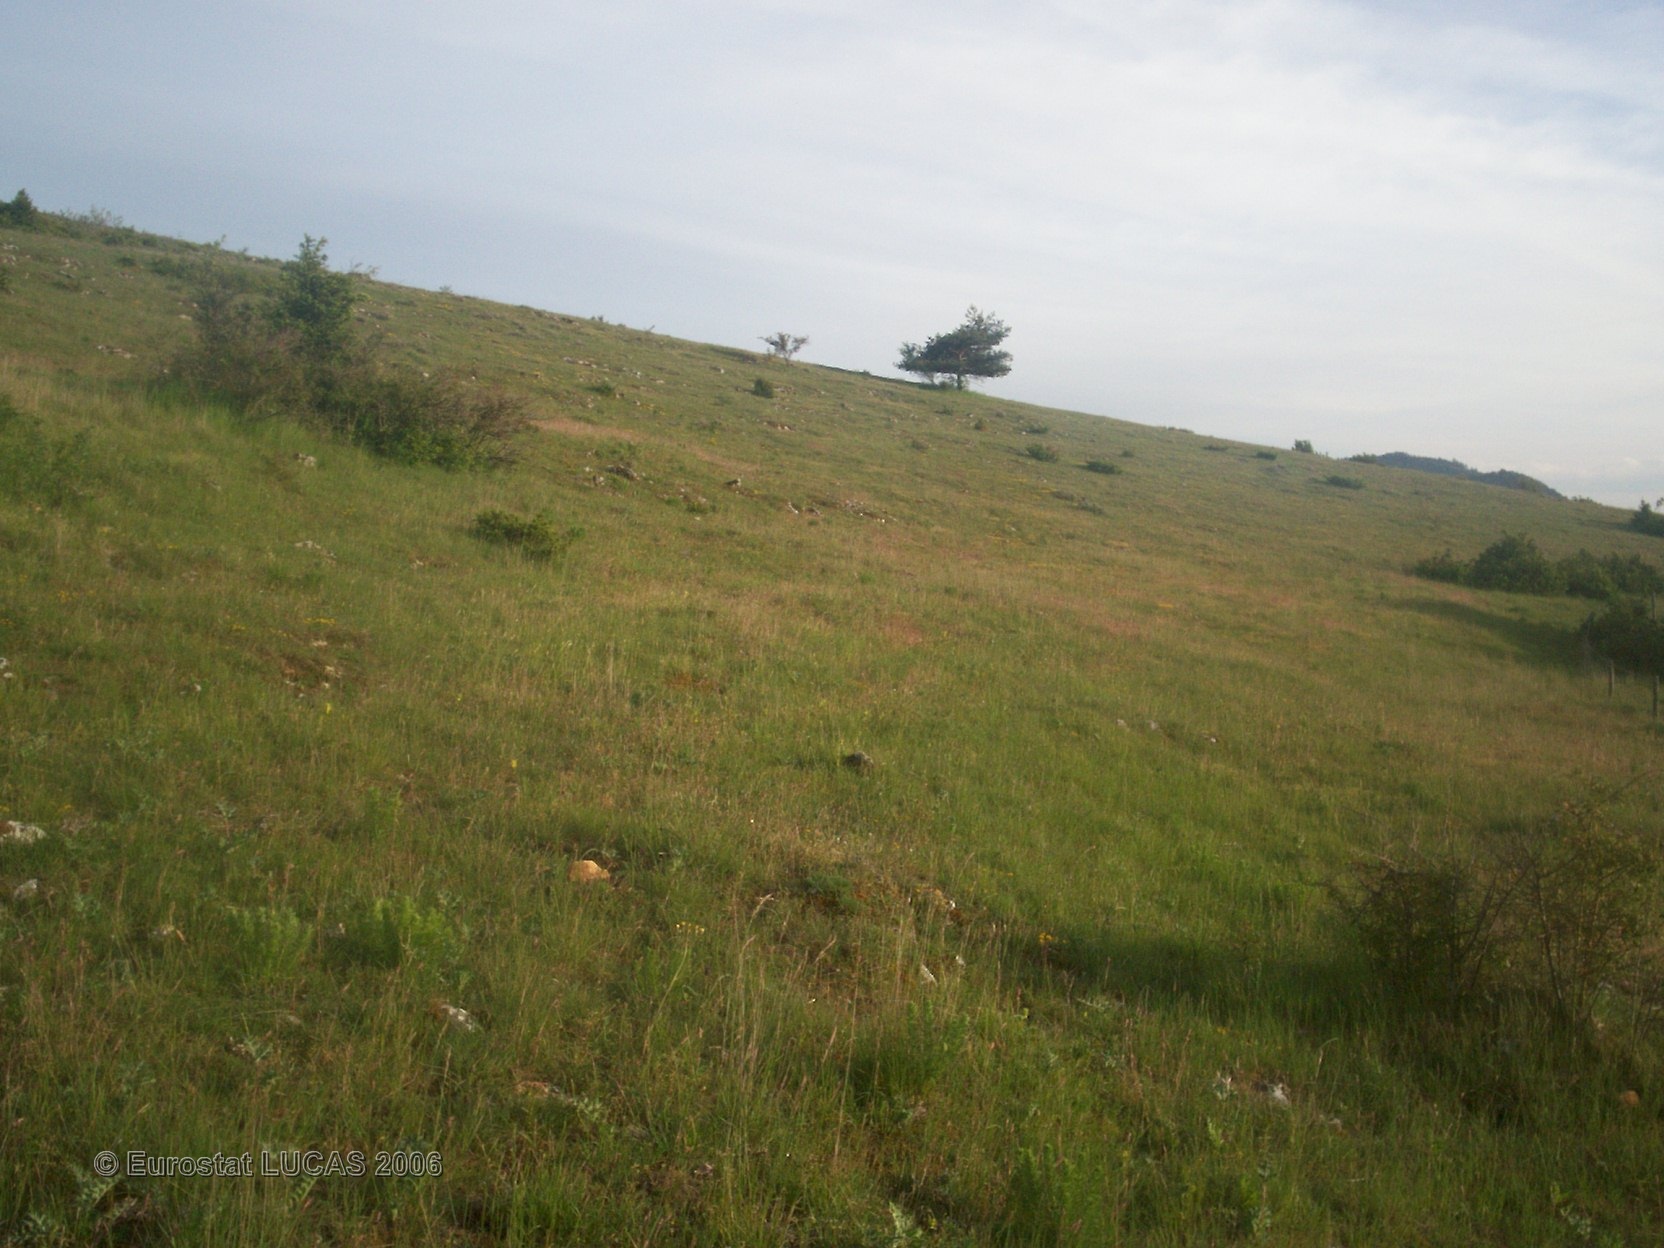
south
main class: Grassland
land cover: Grassland with sparse tree/shrub cover
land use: Agriculture (excluding fallow land and kitchen gardens)
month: June
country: FR
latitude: 44.3782
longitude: 3.4415
